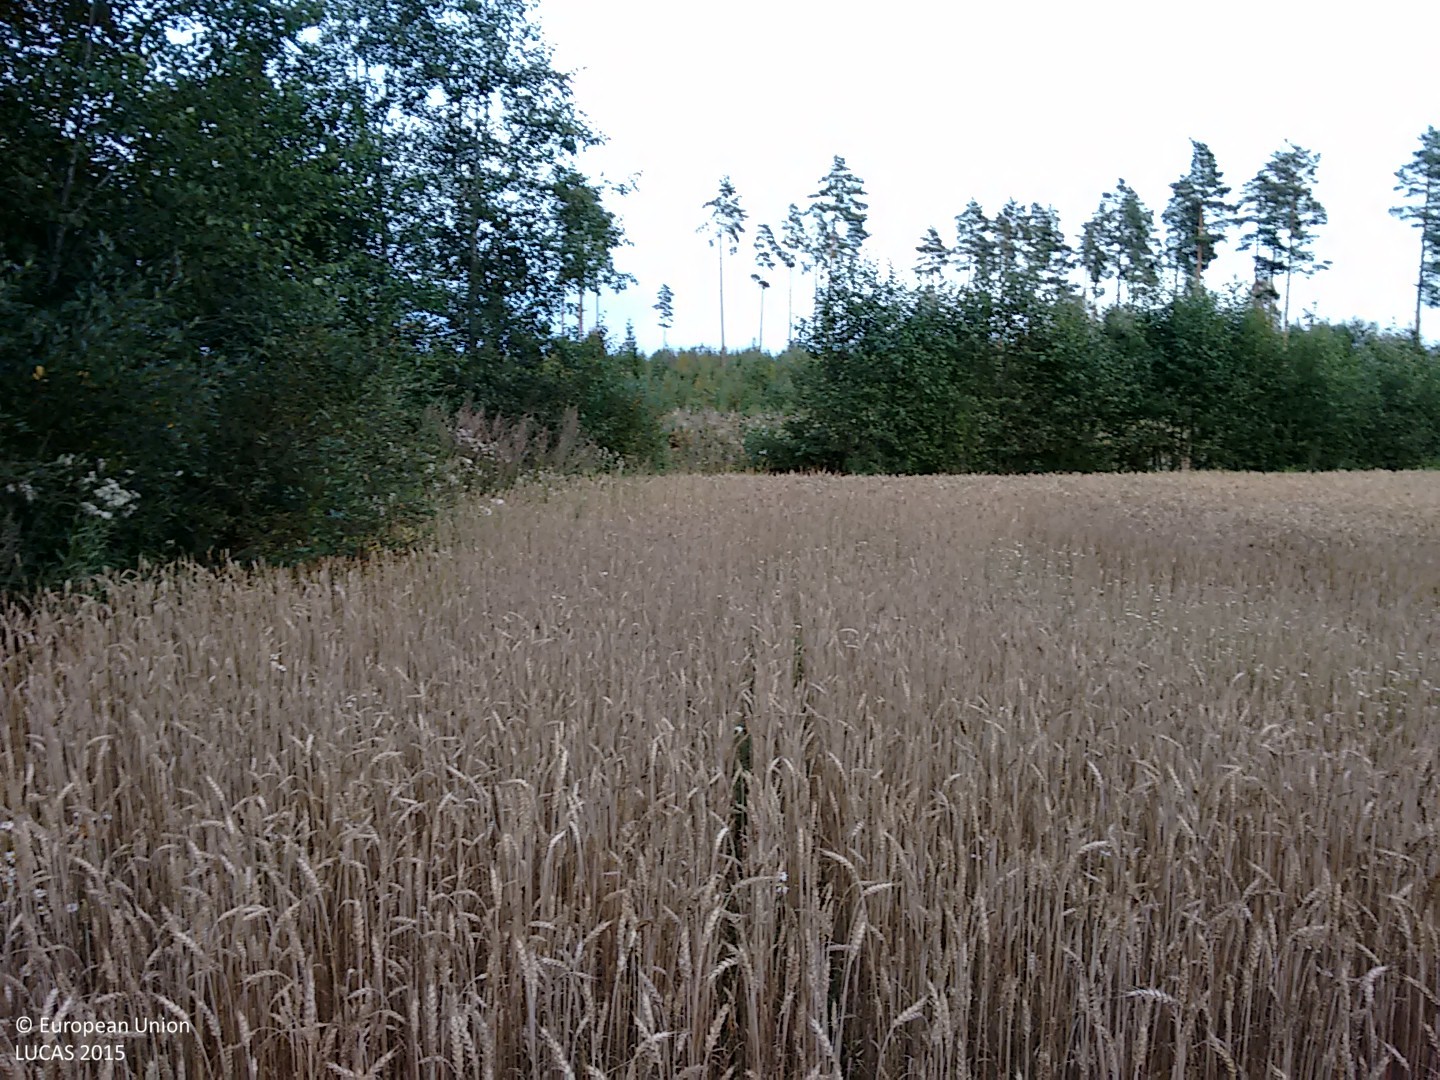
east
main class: Cropland
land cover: Common wheat
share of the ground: > 75 %
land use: Agriculture (excluding fallow land and kitchen gardens)
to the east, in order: Common wheat; Grass margins; Broadleaved woodland; Ditches and canals; Shruby margins; Tracks; Shrubland without tree cover; Ditches and canals; Shrubland without tree cover; Pine dominated mixed woodland; Pine dominated coniferous woodland; Pine dominated mixed woodland
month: September
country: FI
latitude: 60.8754
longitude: 21.9401
